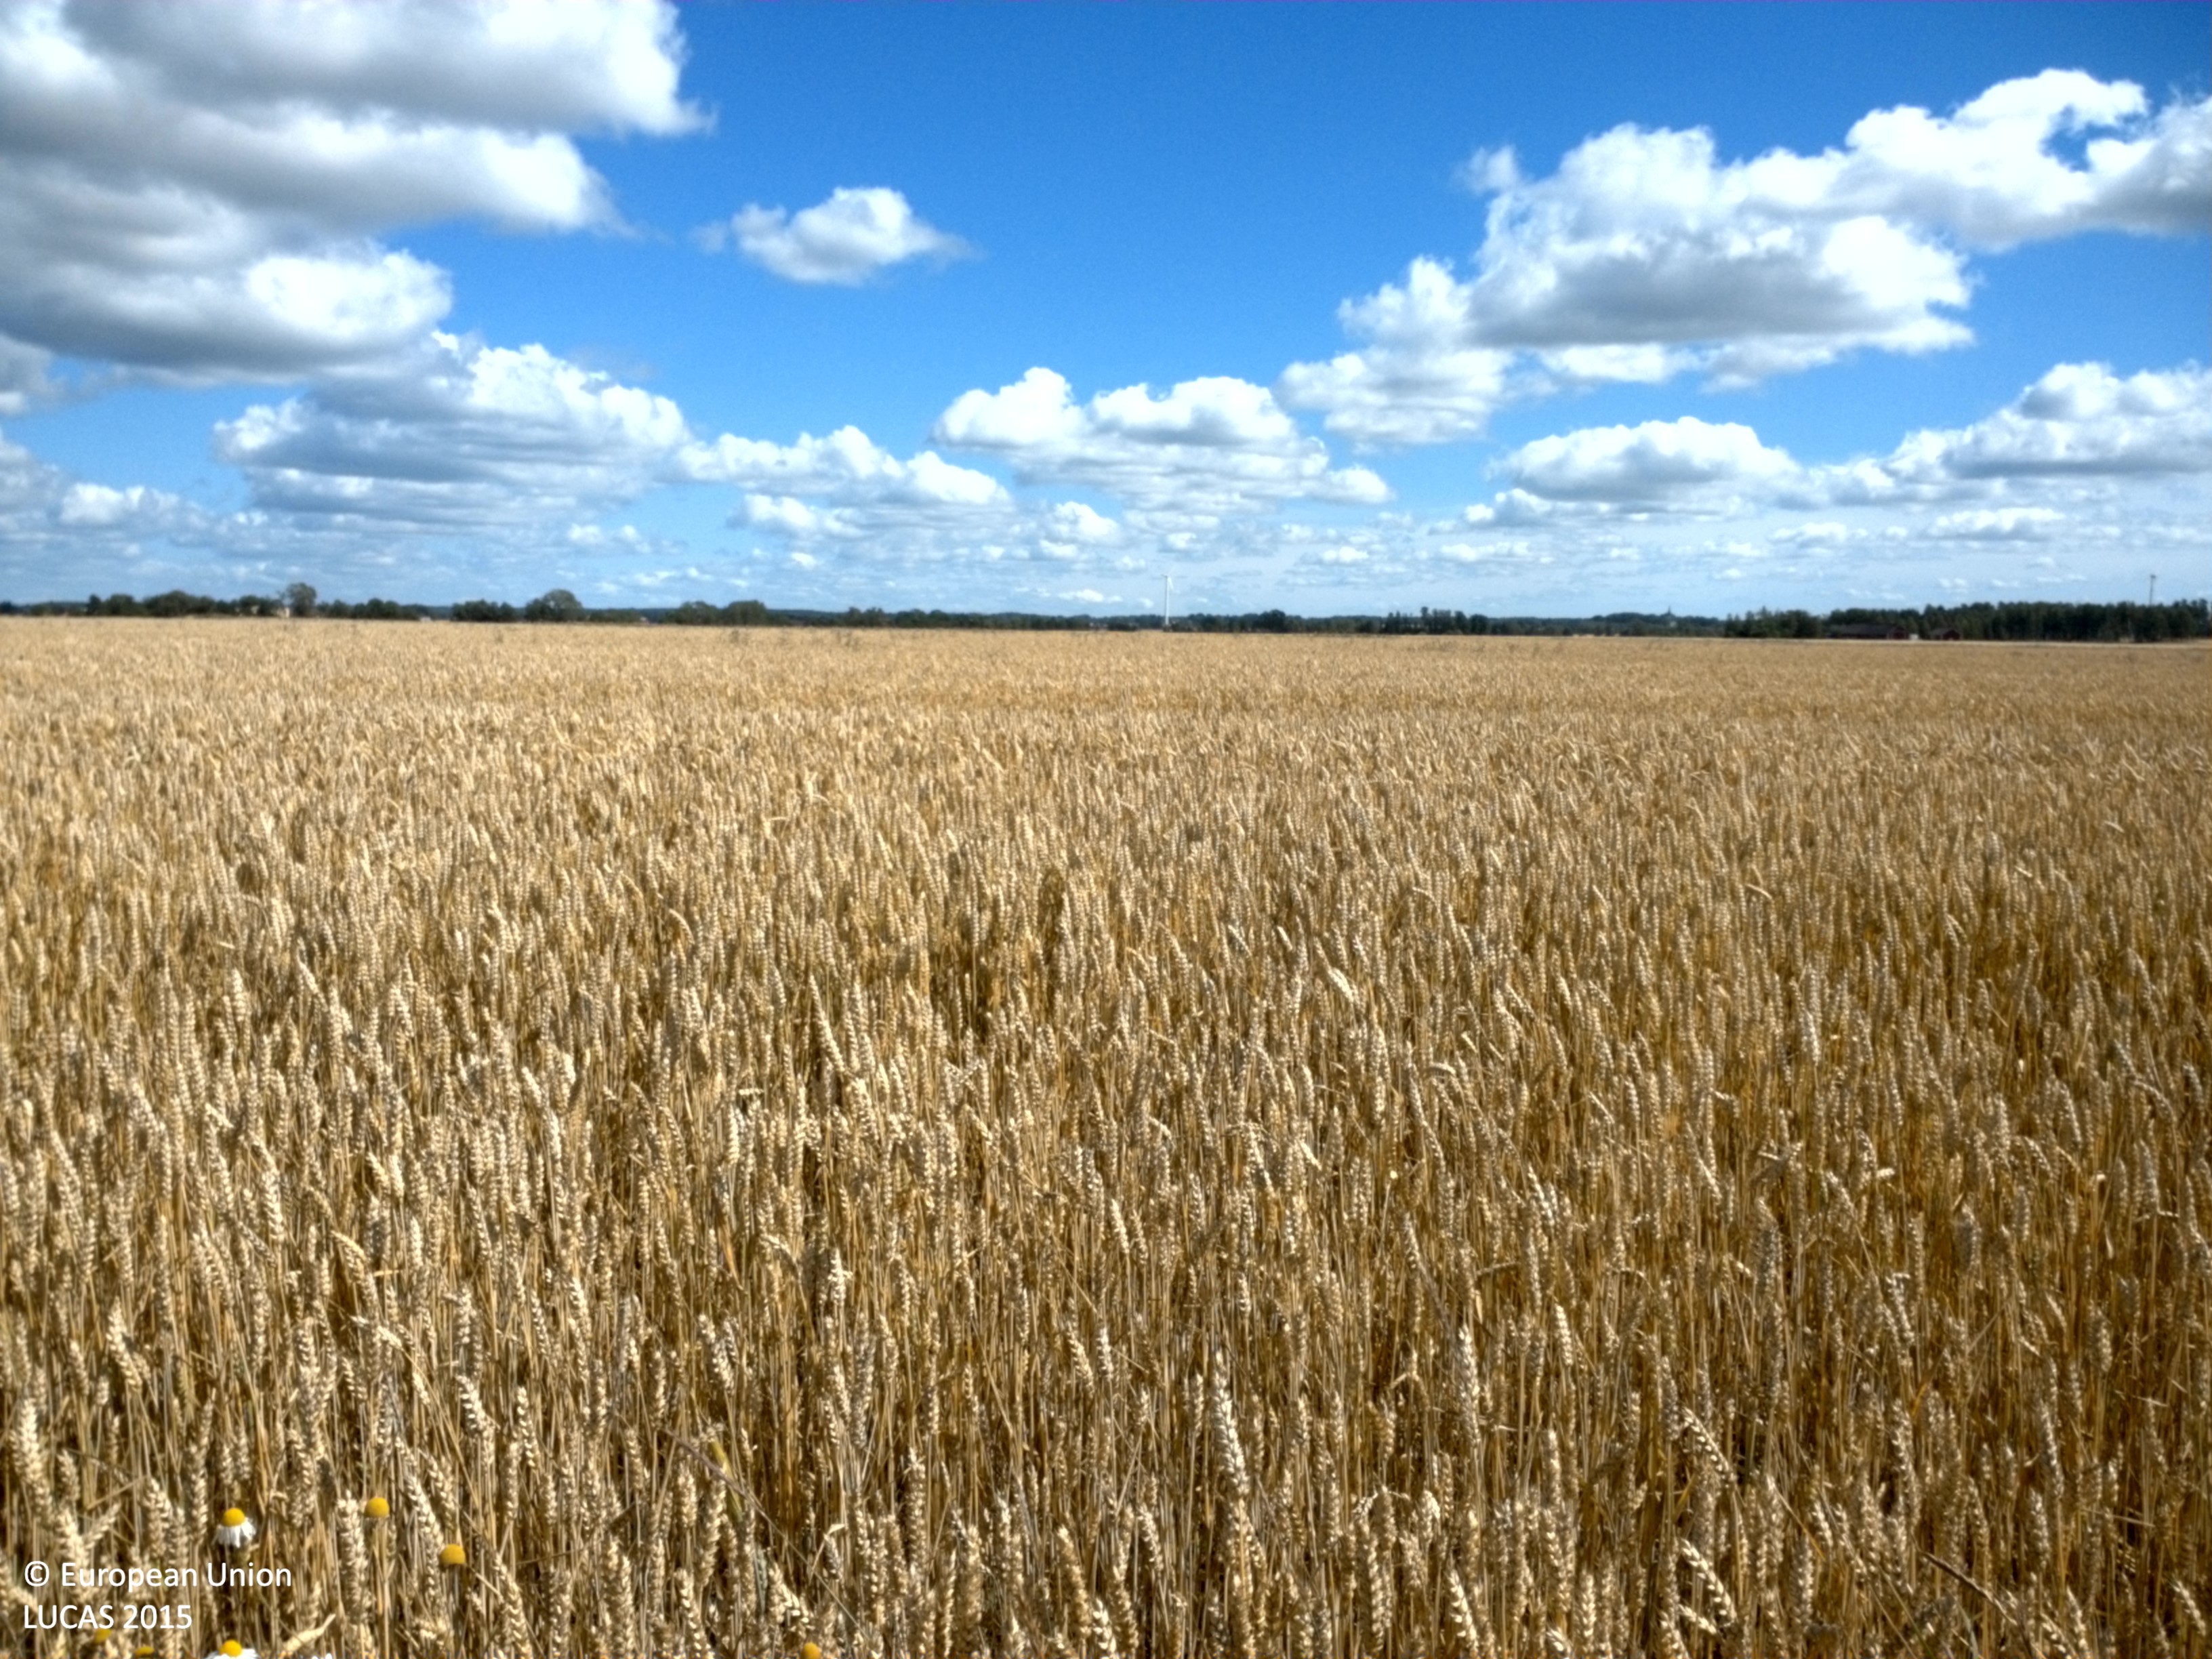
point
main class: Cropland
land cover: Common wheat
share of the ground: > 75 %
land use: Agriculture (excluding fallow land and kitchen gardens)
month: August
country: SE
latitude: 58.2711
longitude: 13.2166
